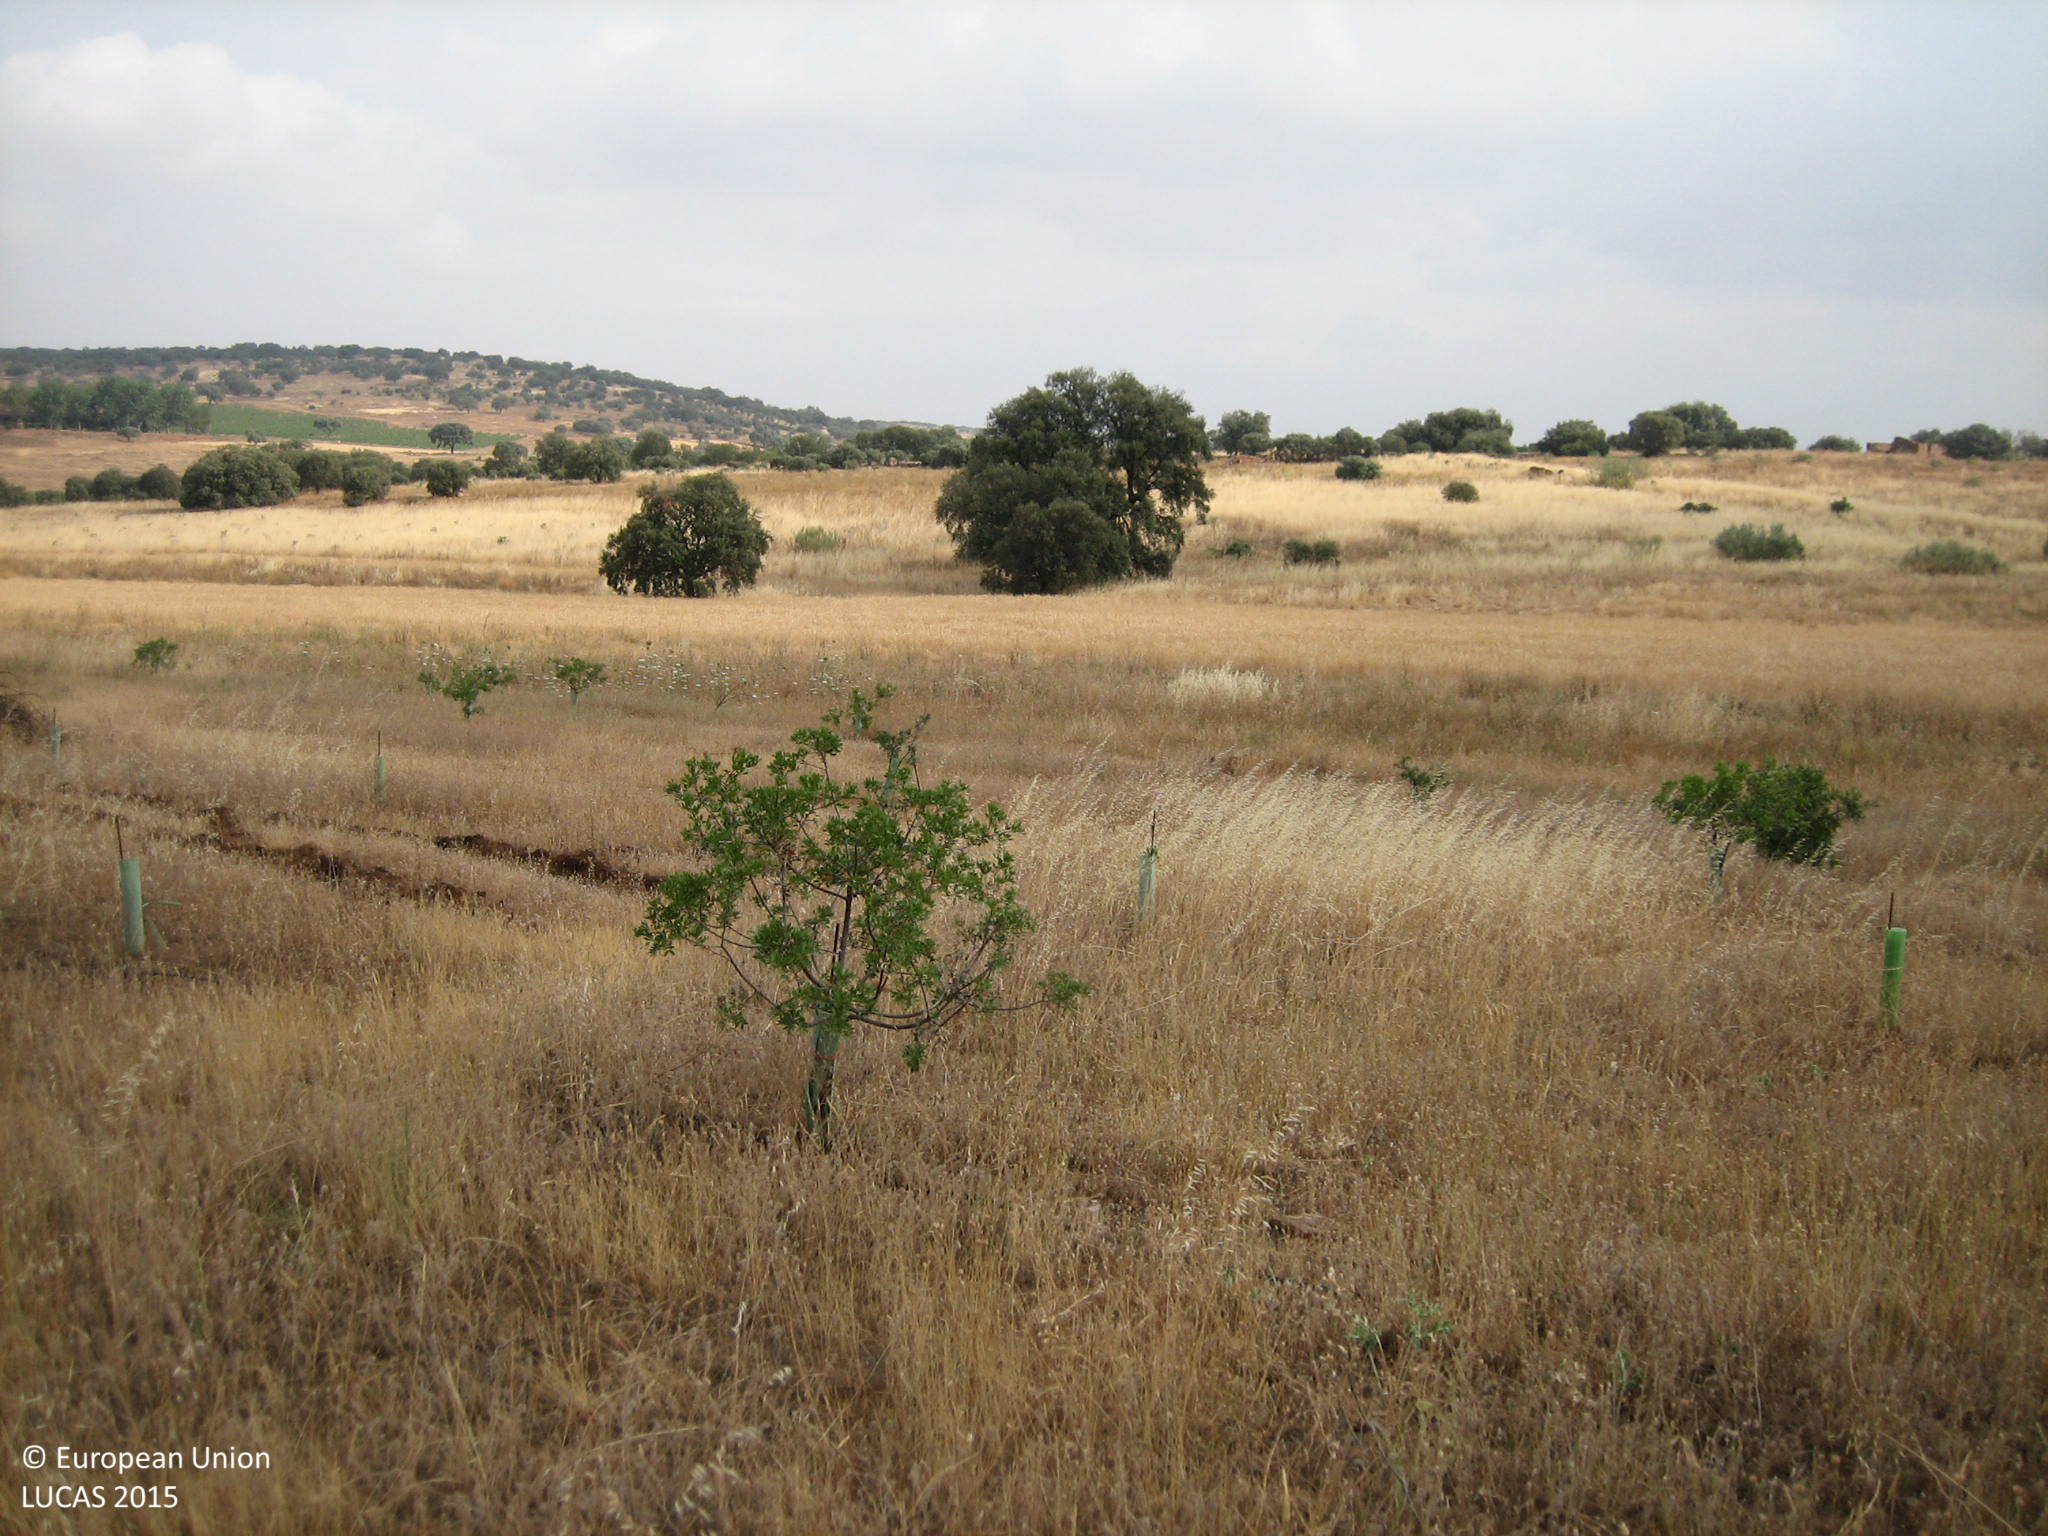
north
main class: Grassland
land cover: Grassland with sparse tree/shrub cover
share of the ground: > 75 %
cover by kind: herbaceous plants 90 %, broadleaved forest trees 5 %, shrubs 5 %
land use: Semi-natural and natural areas not in use
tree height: < 5 m
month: June
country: ES
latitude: 38.9372
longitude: -4.0614
